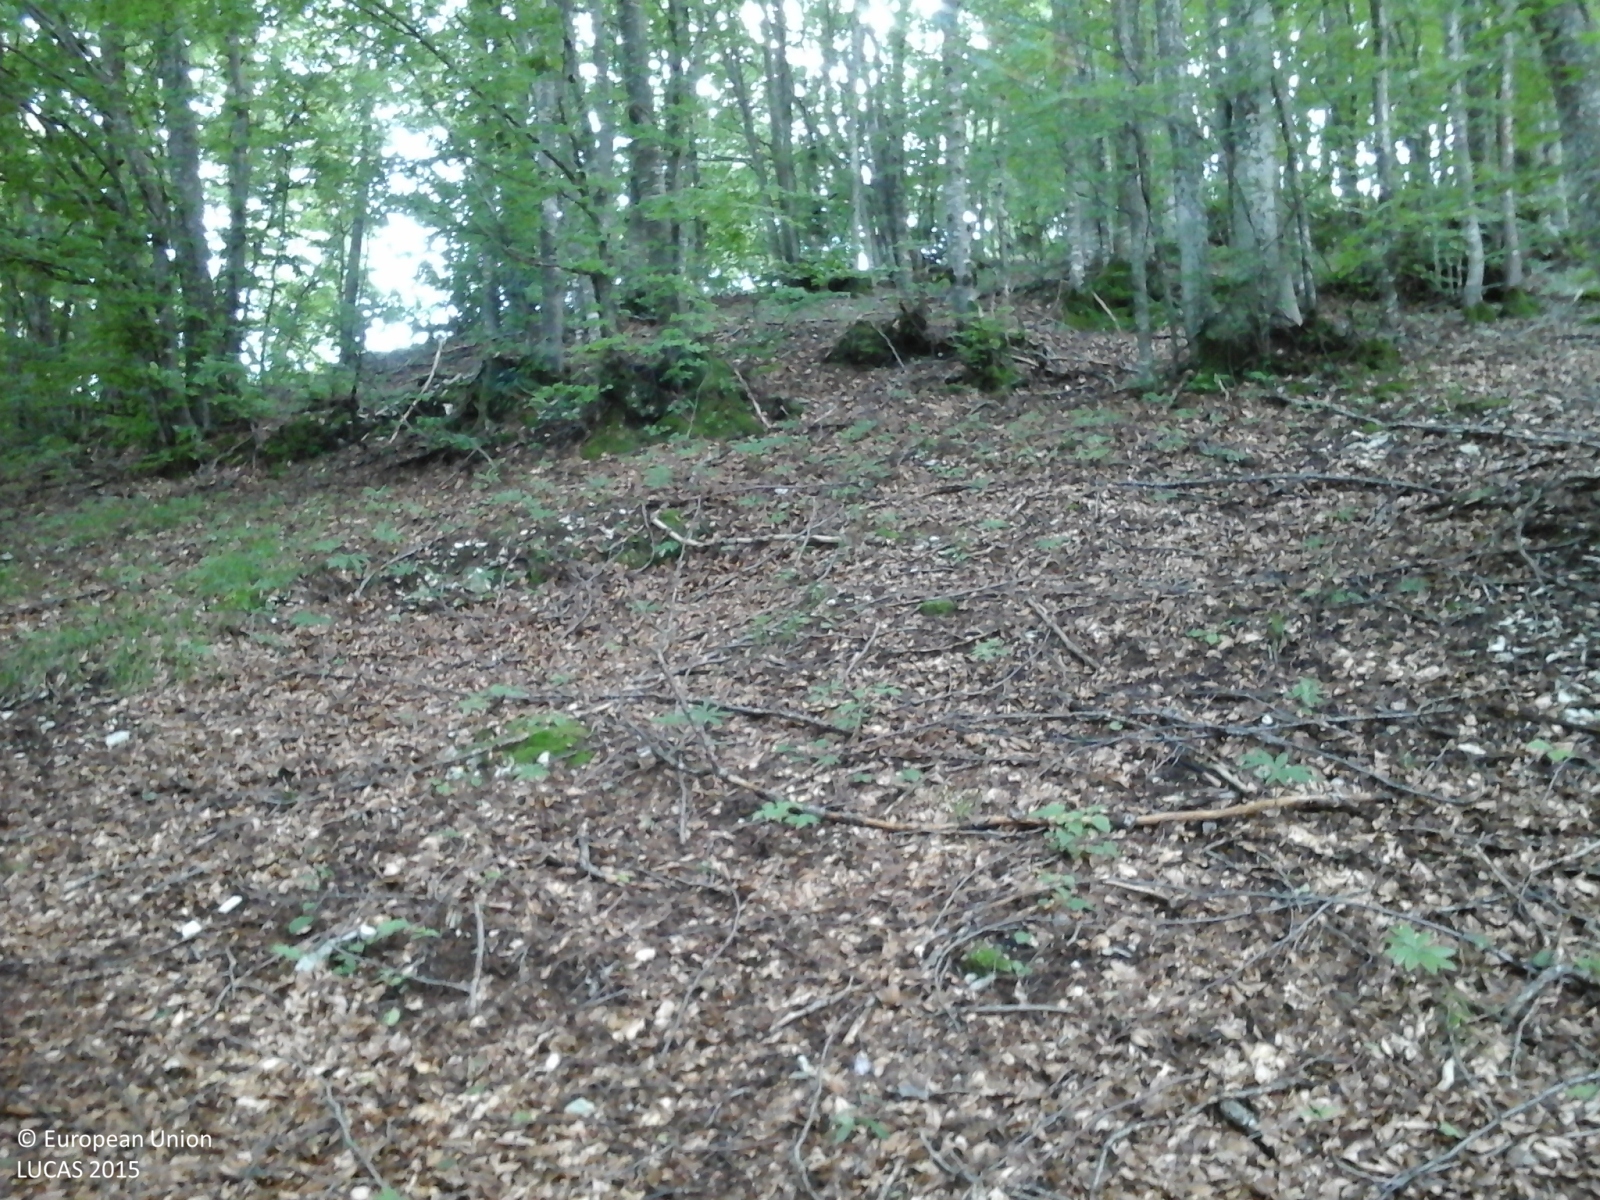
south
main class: Woodland
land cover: Broadleaved woodland
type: mountainous beech forest
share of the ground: > 75 %
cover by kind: broadleaved forest trees 100 %
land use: Forestry
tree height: > 5 m
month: June
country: IT
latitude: 45.8706
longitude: 11.6080
